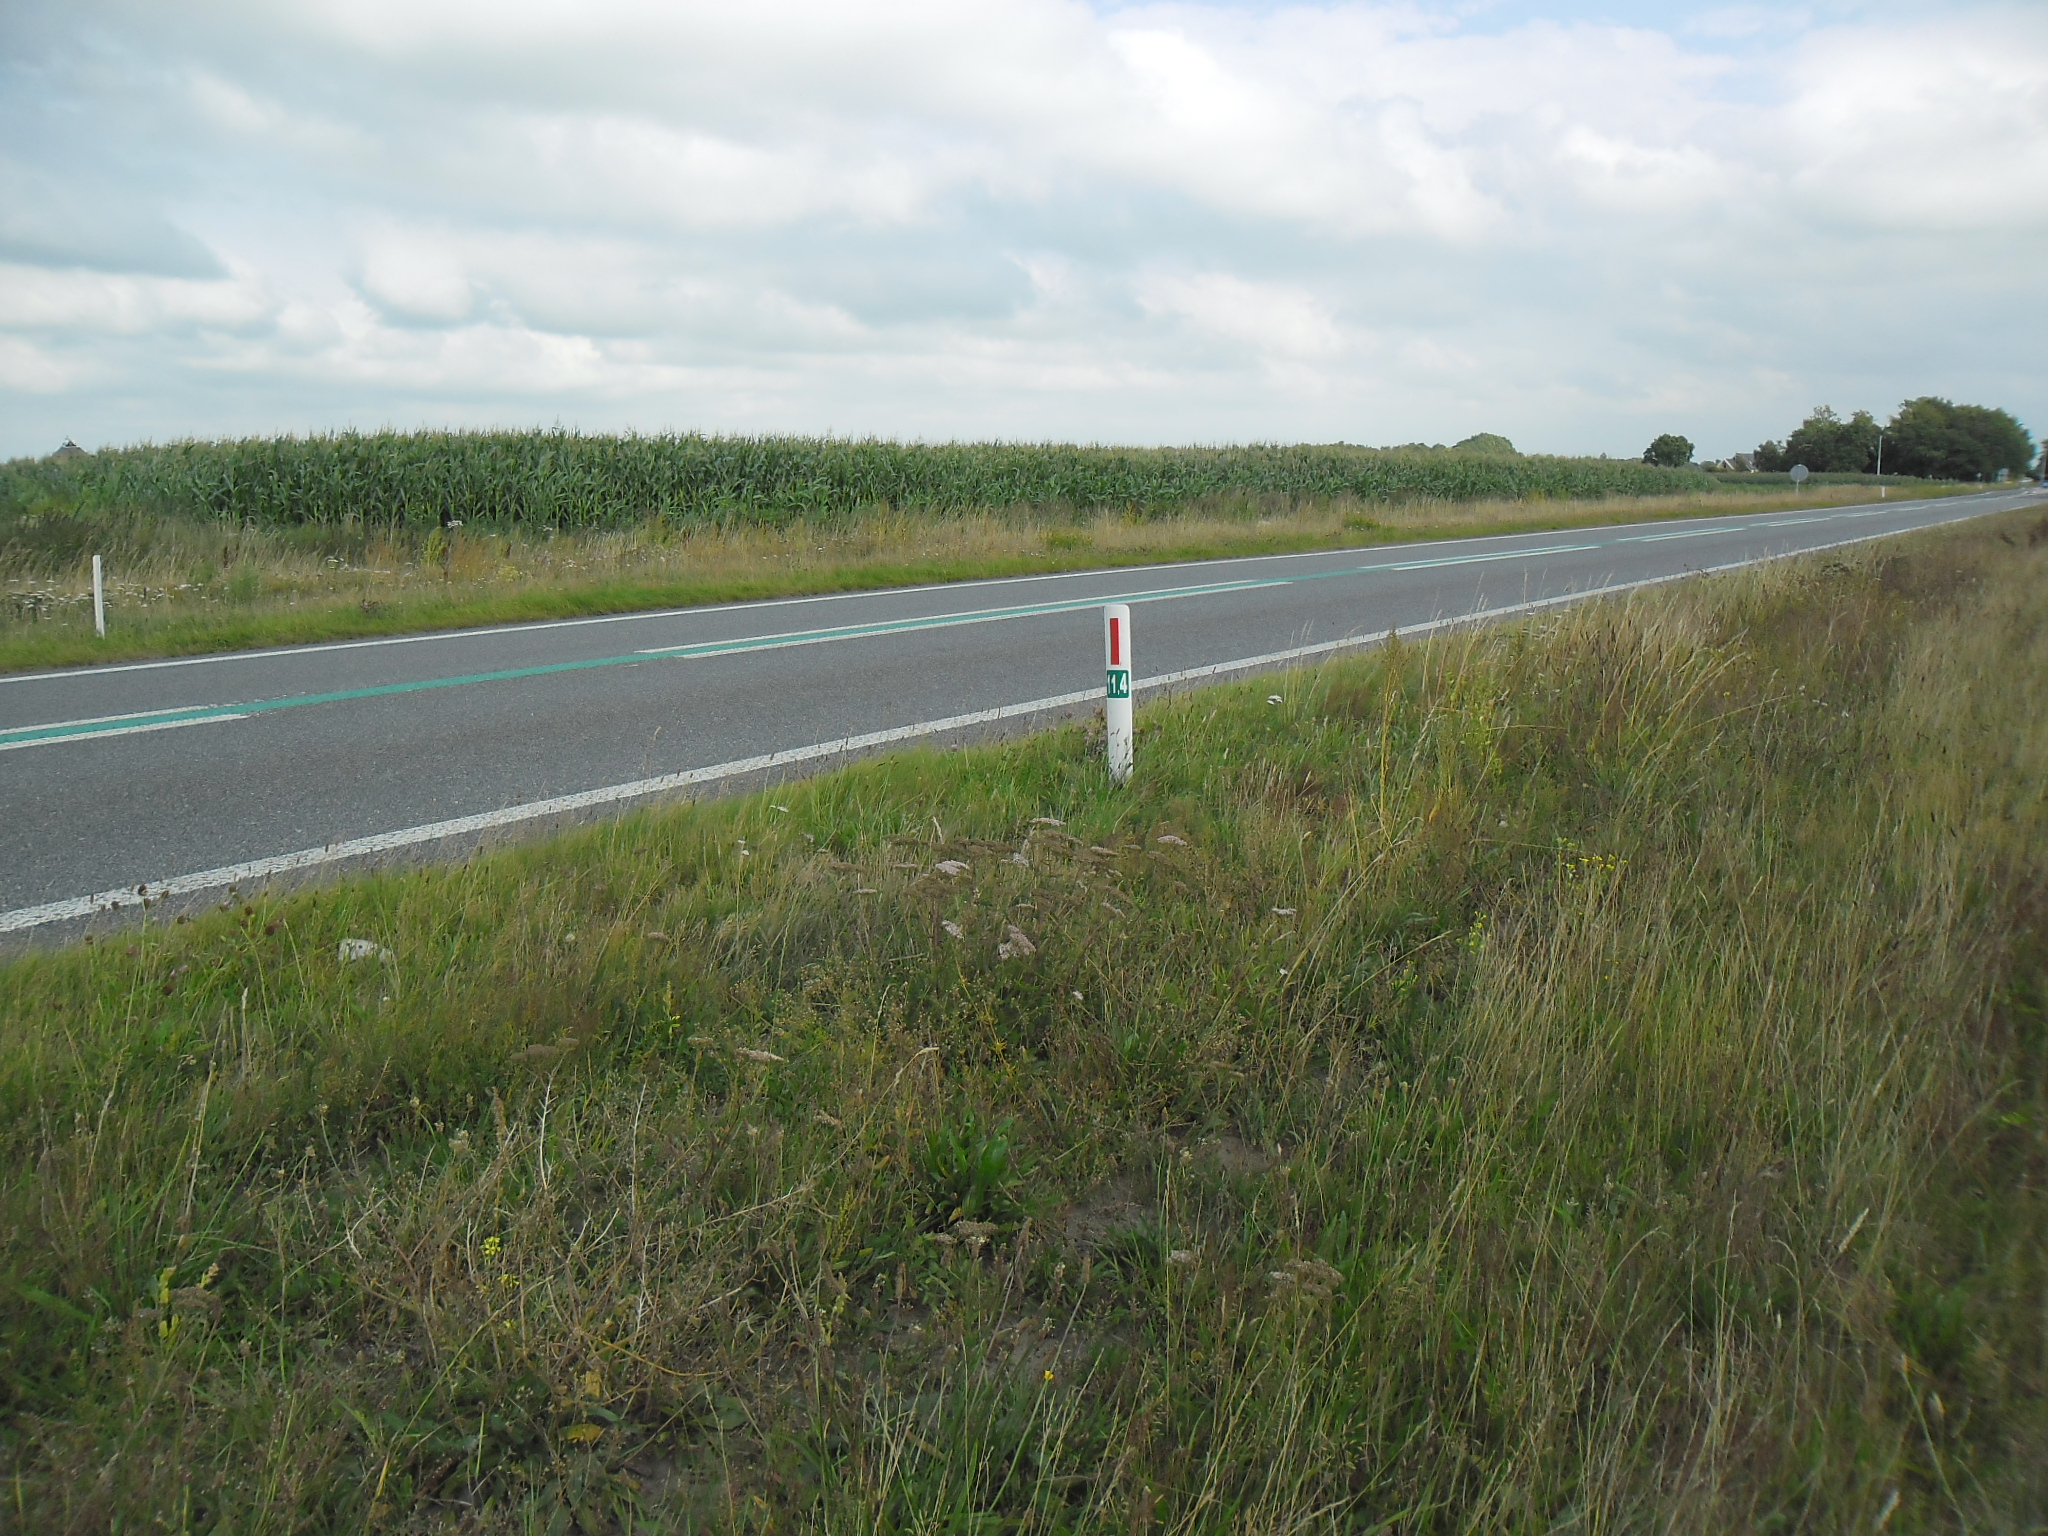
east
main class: Cropland
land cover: Maize
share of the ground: > 75 %
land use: Agriculture (excluding fallow land and kitchen gardens)
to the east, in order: Maize; Ditches and canals; Grassland without tree/shrub cover; Paved roads, cycling and walking lanes; Grassland without tree/shrub cover; Ditches and canals; Shruby margins; Maize; Fences; Shruby margins; Other root crops
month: August
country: NL
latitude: 52.8895
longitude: 5.5845
